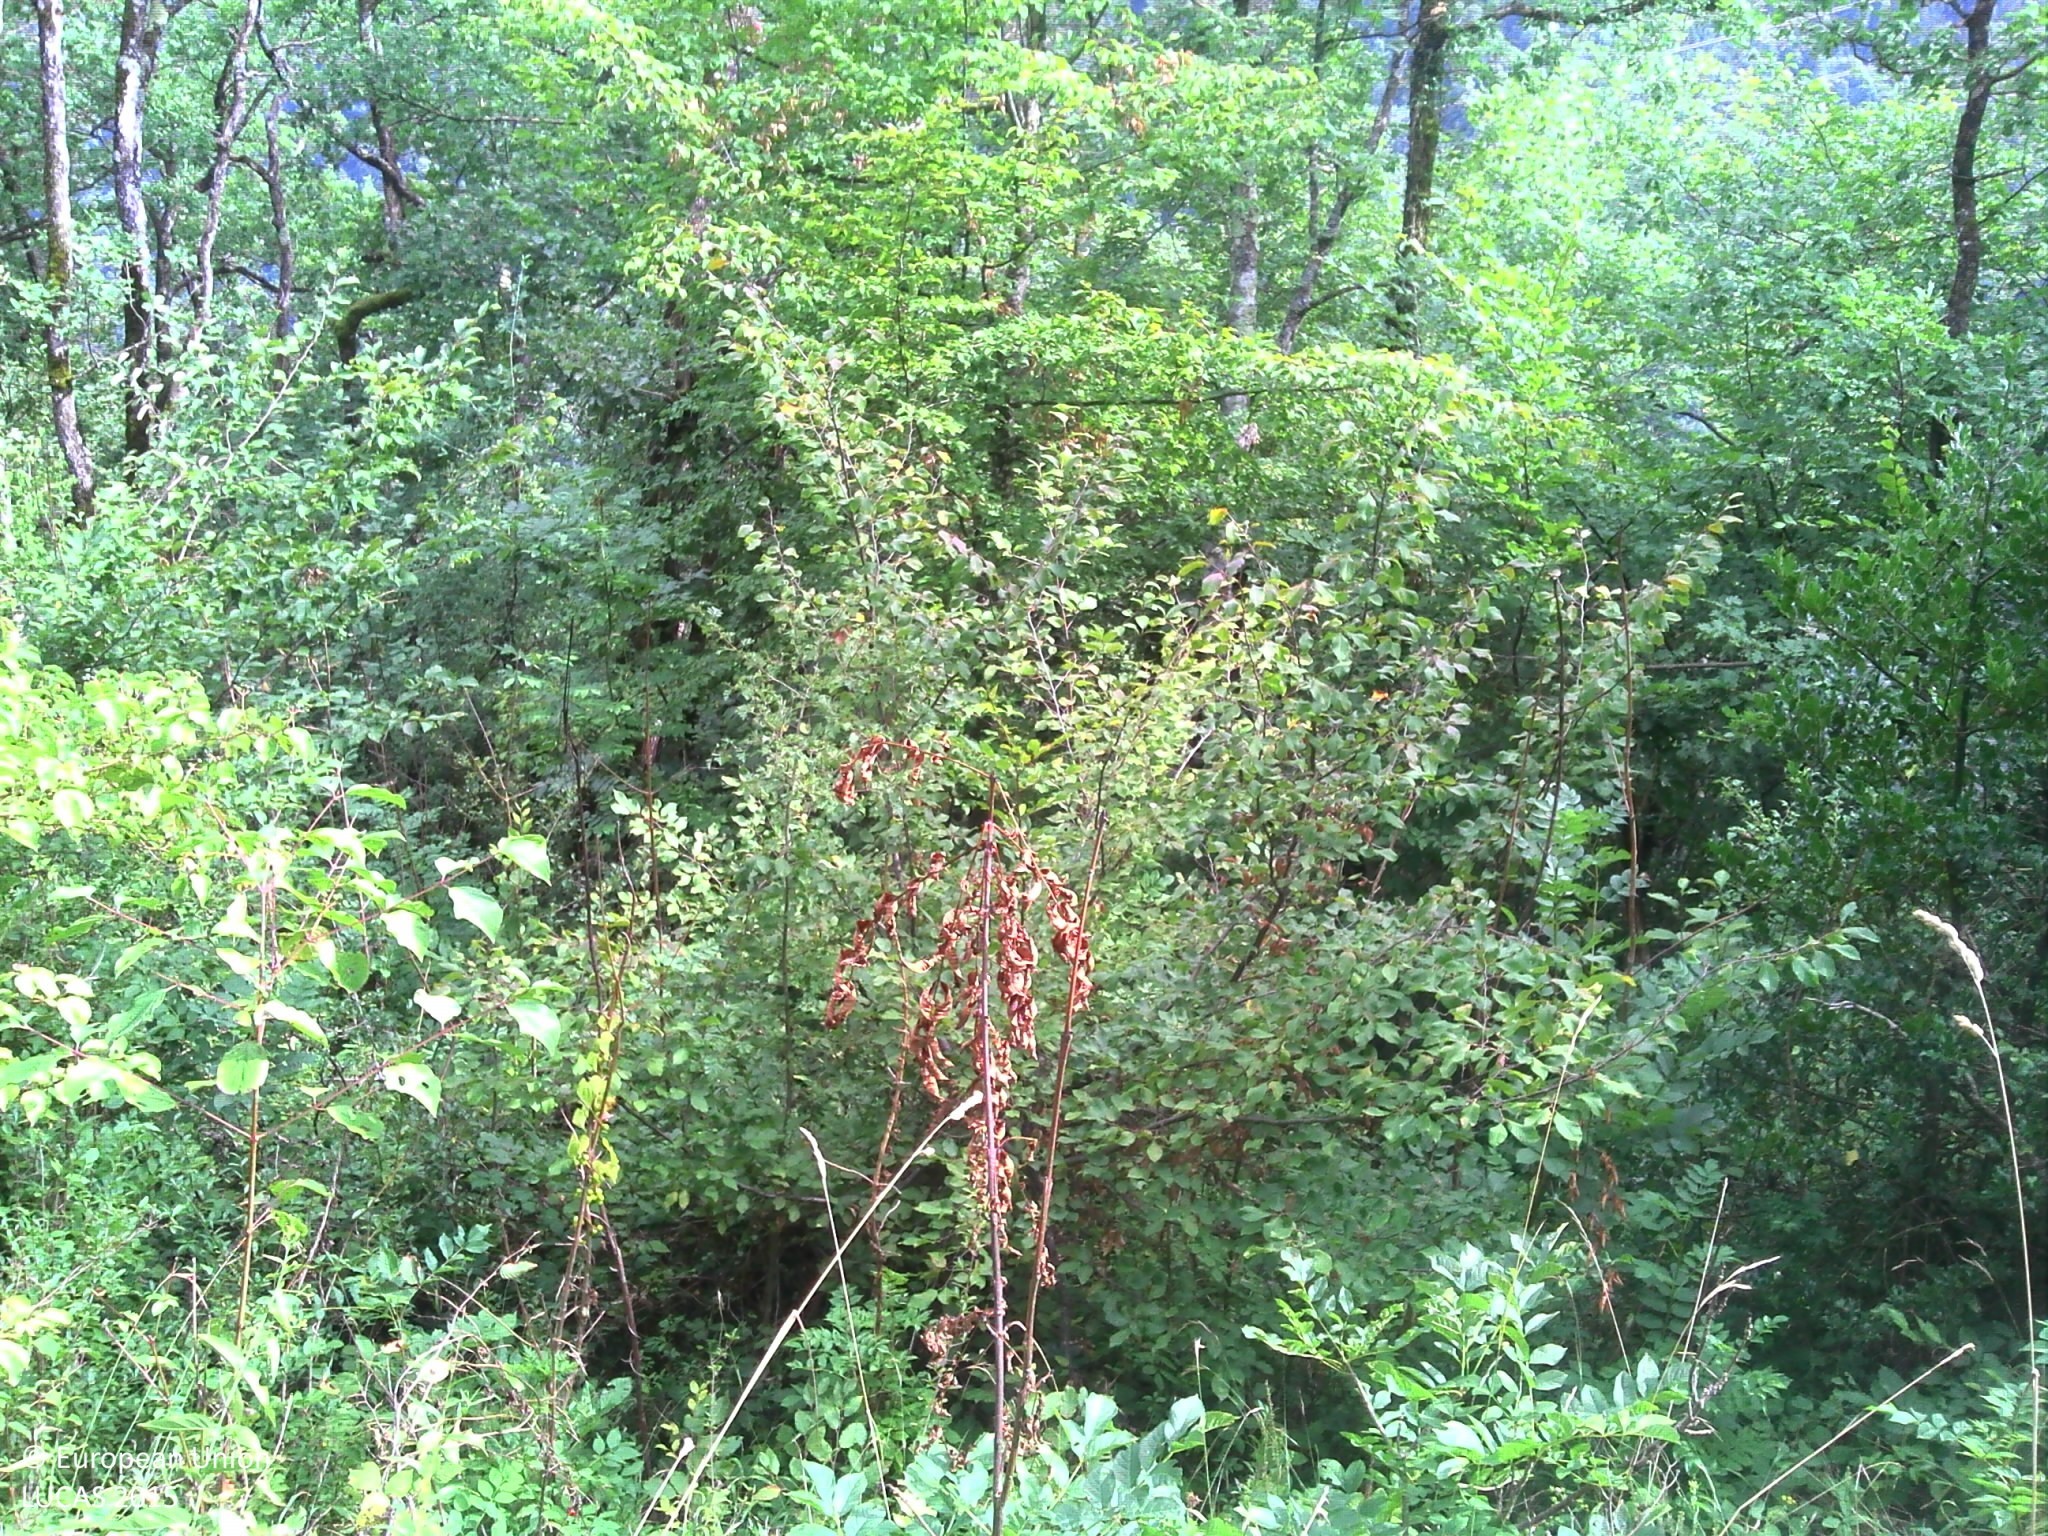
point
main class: Woodland
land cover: Broadleaved woodland
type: mesophytic deciduous forest
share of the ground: > 75 %
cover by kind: broadleaved forest trees 80 %, unconsolidated bare surface 10 %, coniferous forest trees 5 %, lichens and mosses 5 %
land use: Forestry
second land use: Sport
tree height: > 5 m
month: August
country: FR
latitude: 45.2676
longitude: 5.5826
